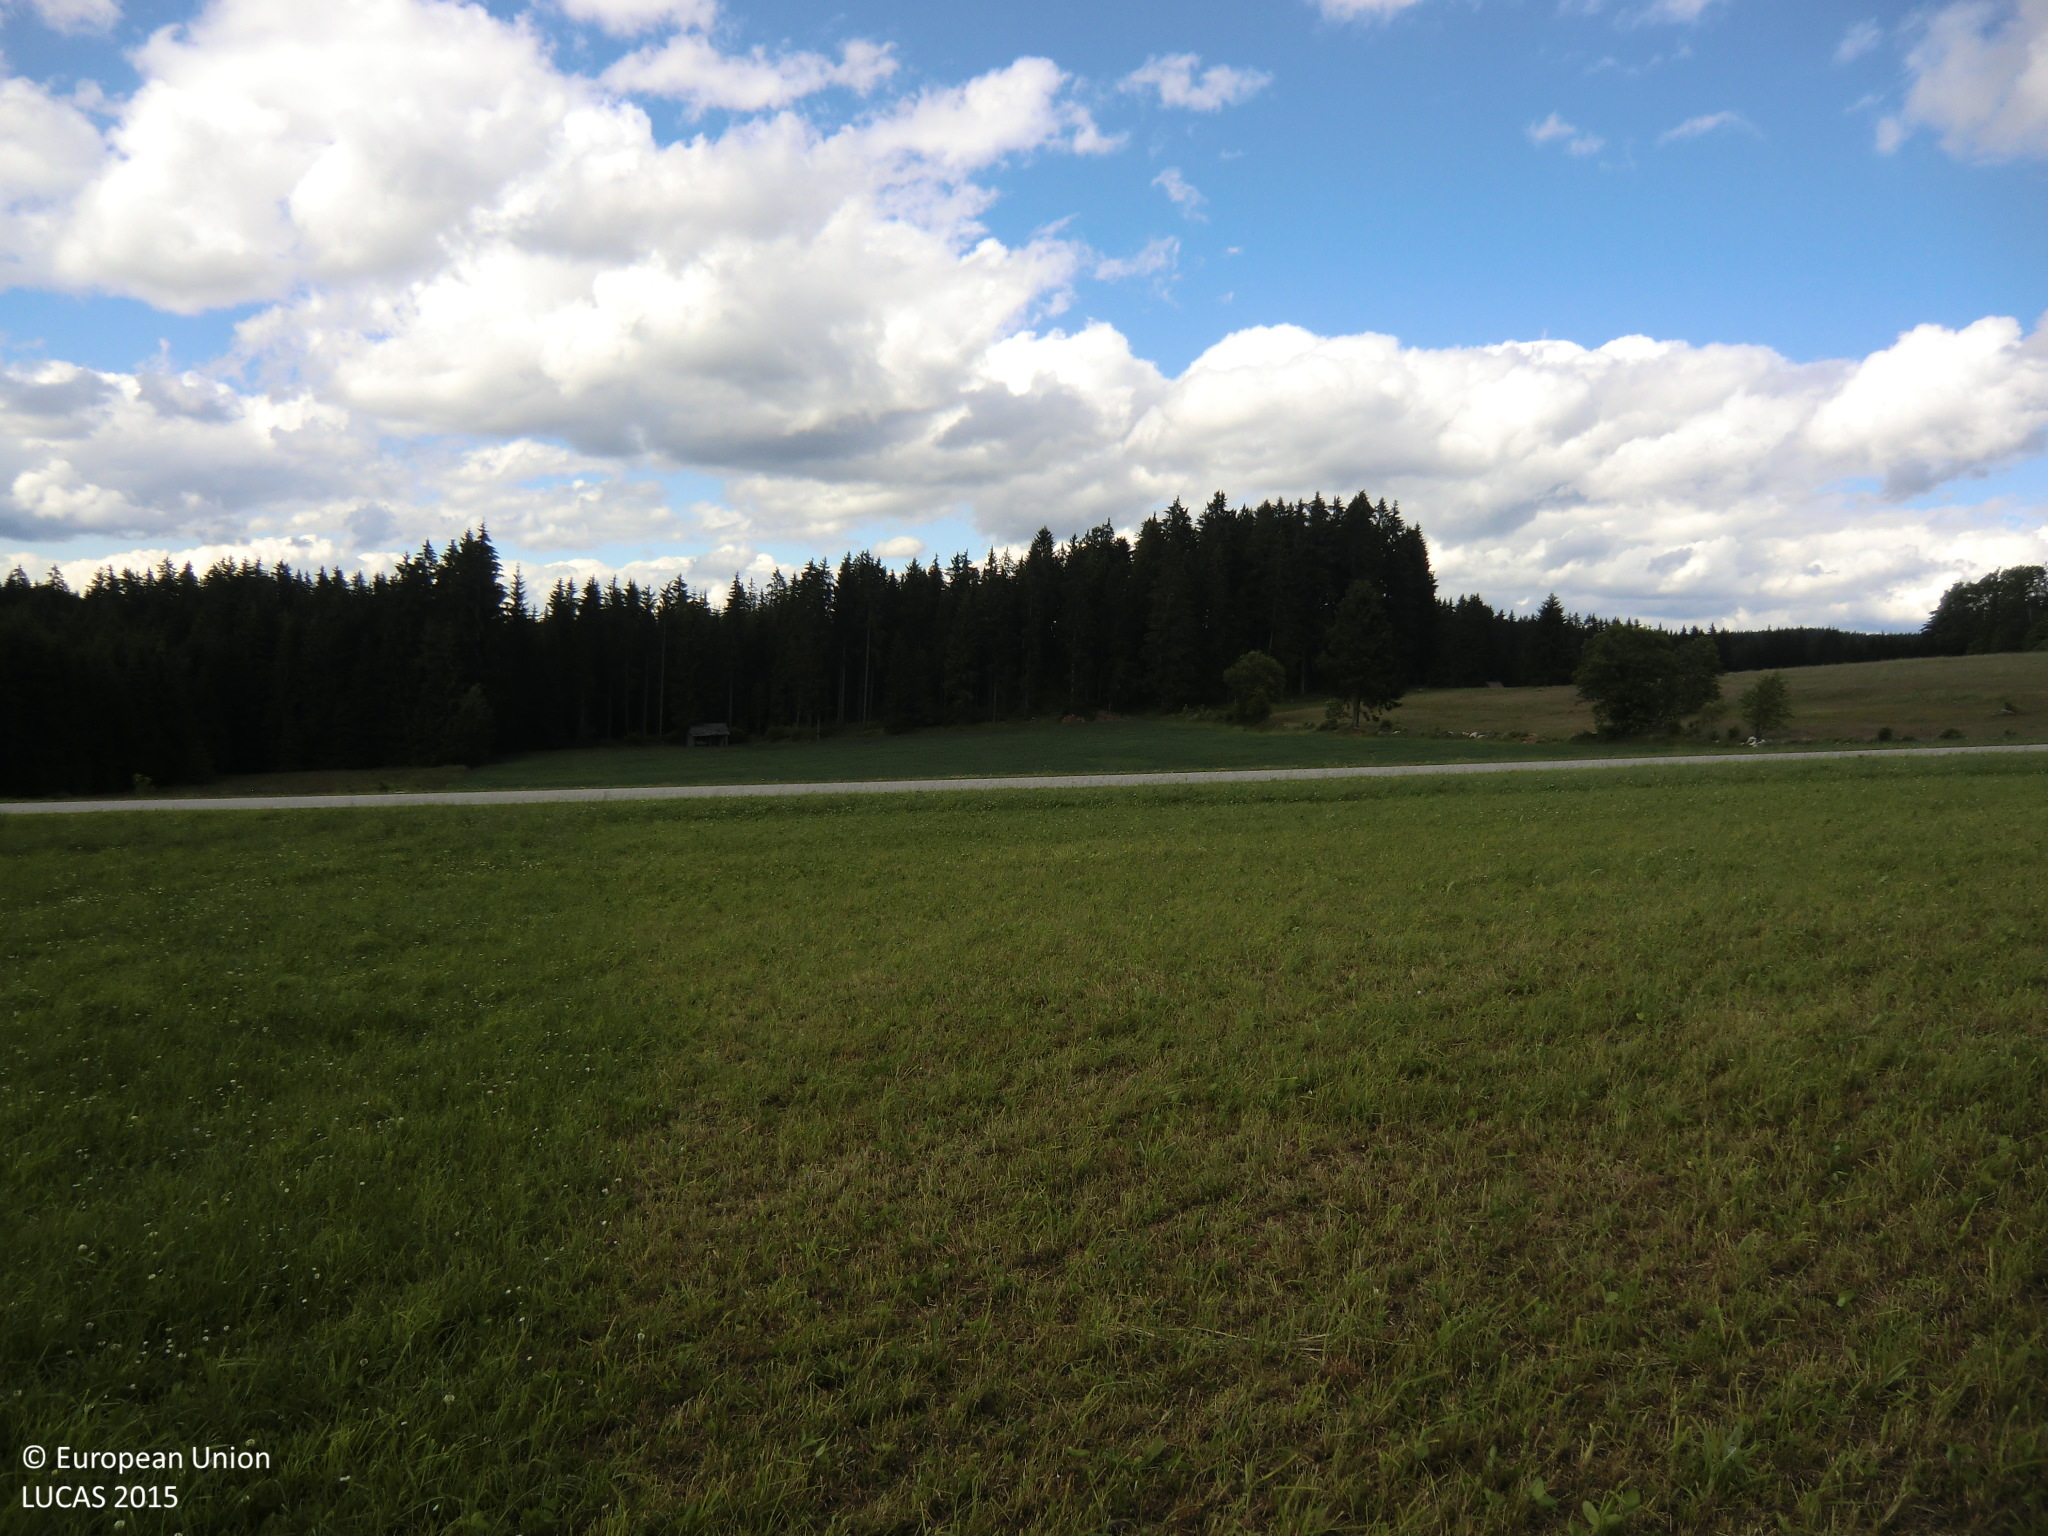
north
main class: Cropland
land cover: Temporary grasslands
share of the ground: 50 - 75 %
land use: Agriculture (excluding fallow land and kitchen gardens)
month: June
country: AT
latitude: 48.5367
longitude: 14.7278
